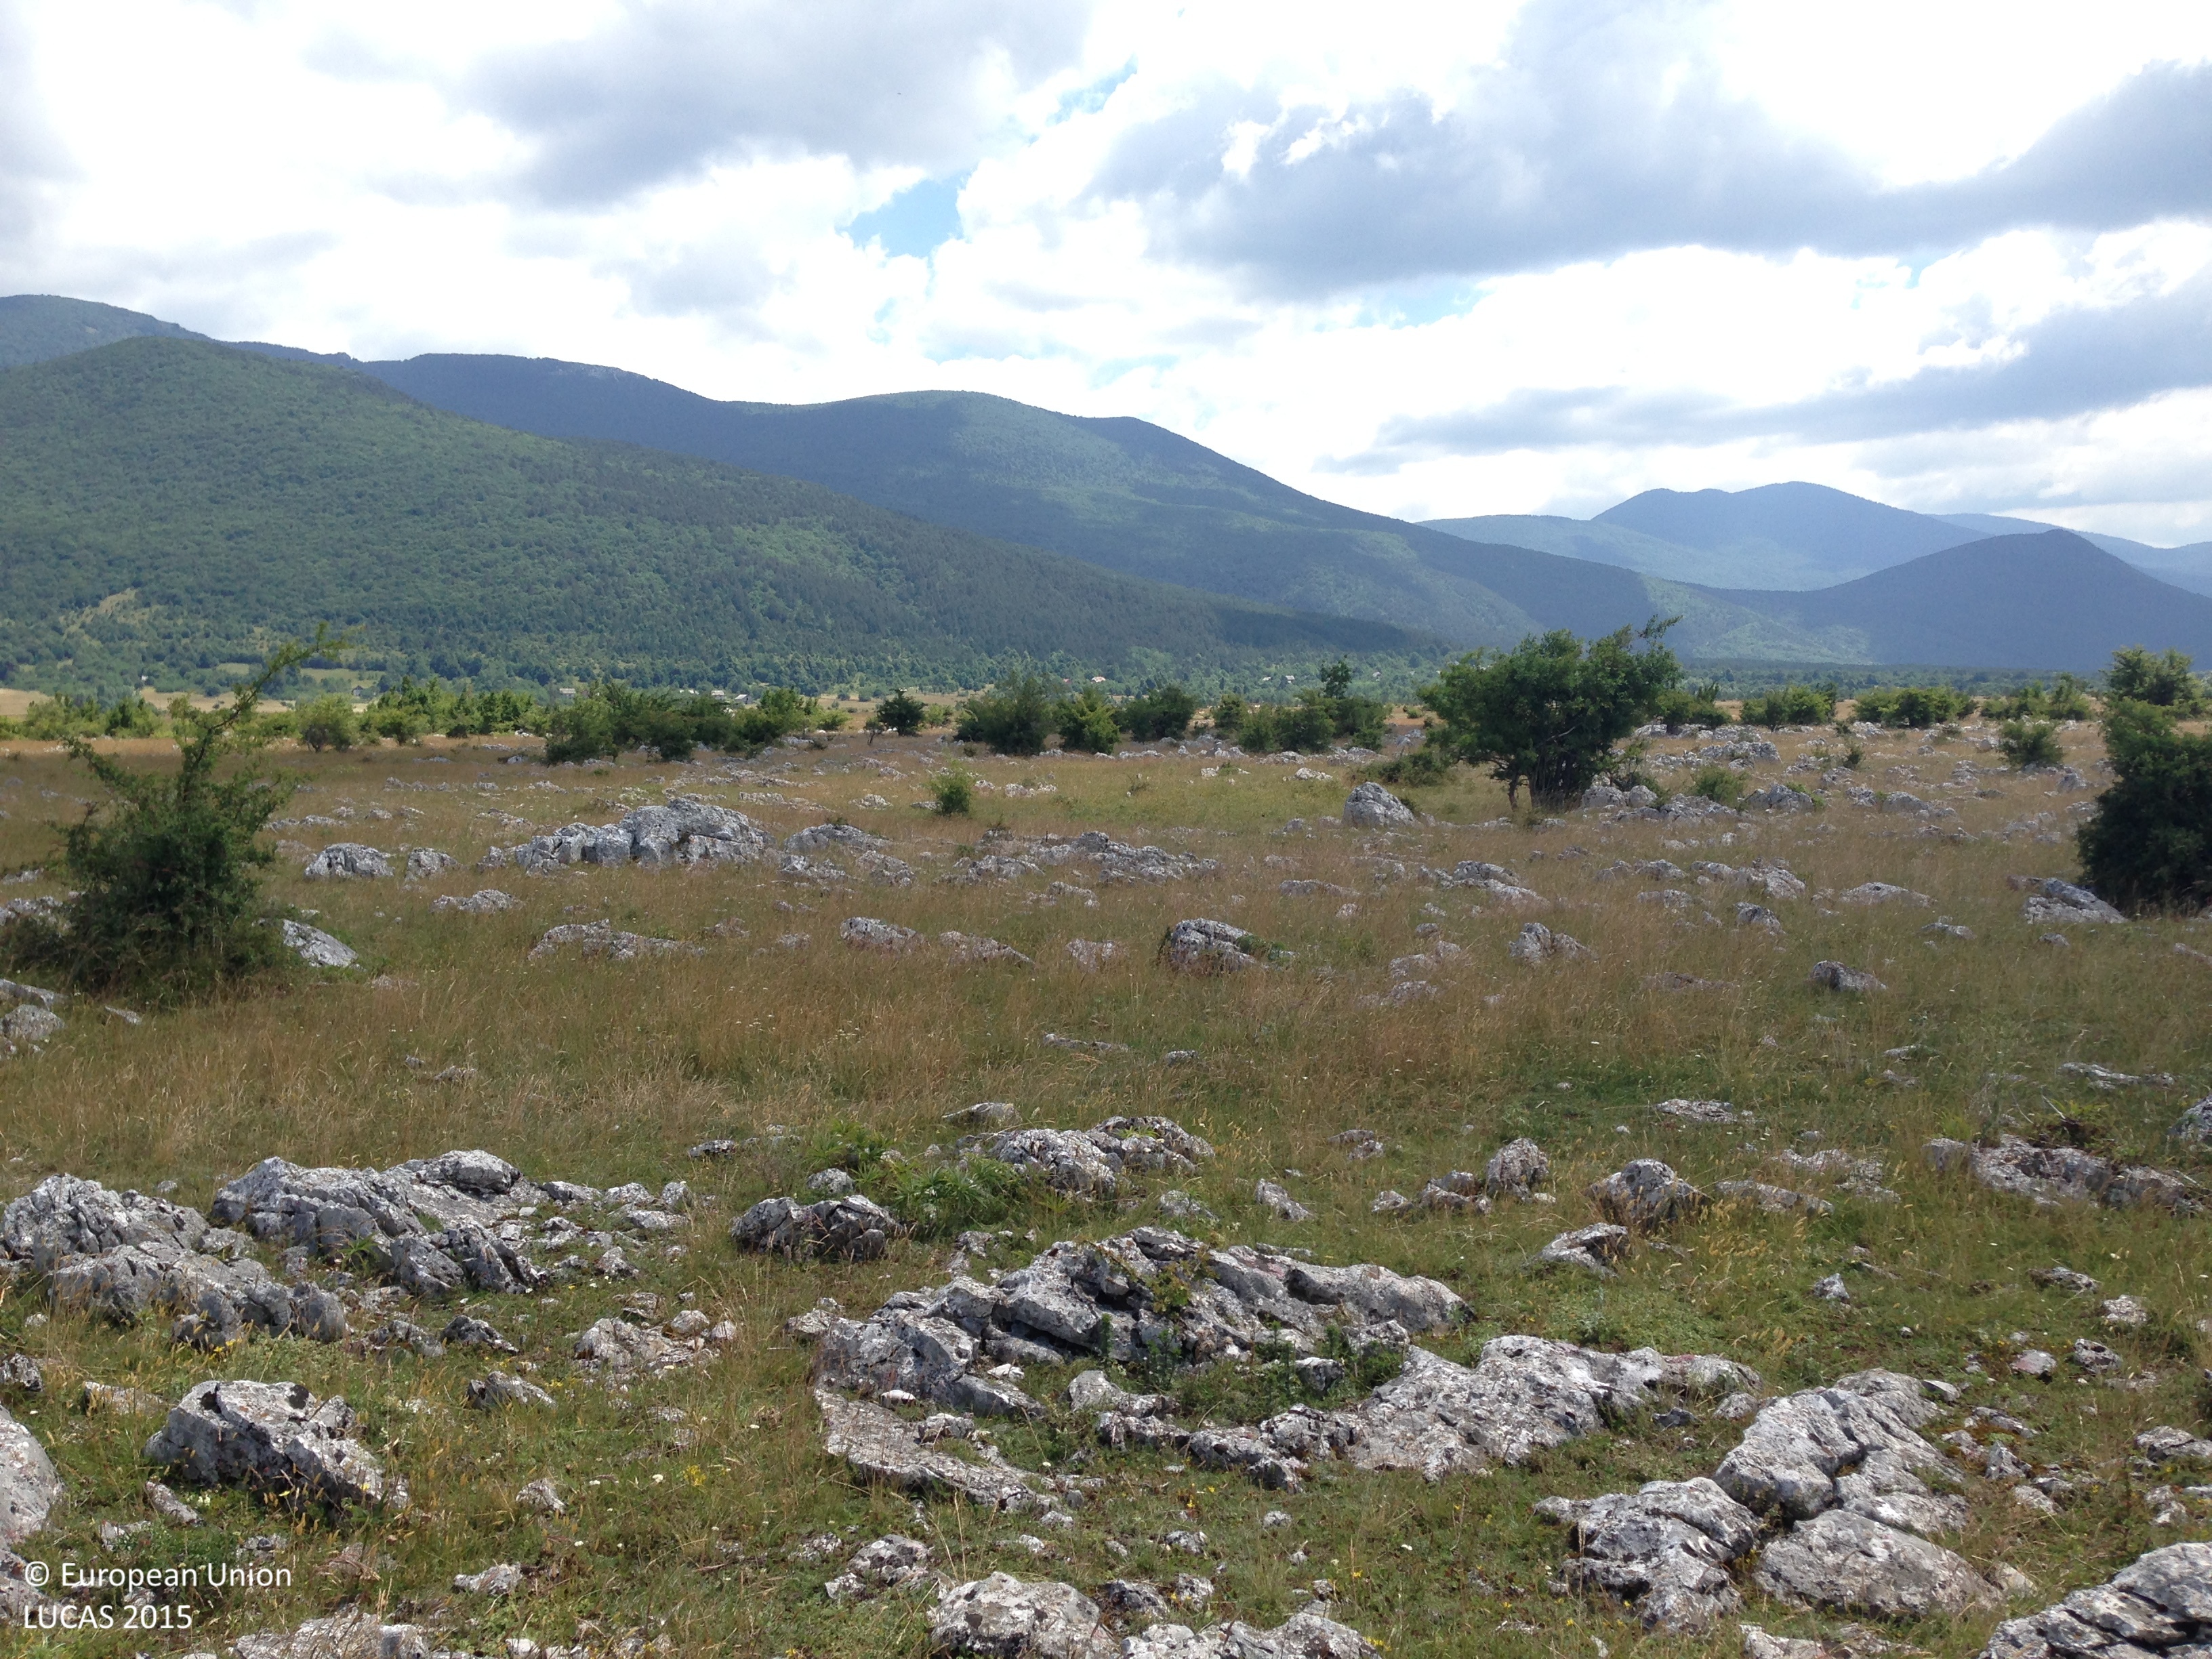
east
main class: Grassland
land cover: Grassland with sparse tree/shrub cover
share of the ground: > 75 %
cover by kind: herbaceous plants 65 %, unconsolidated bare surface 15 %, consolidated bare surface 10 %, broadleaved forest trees 5 %, shrubs 5 %
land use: Semi-natural and natural areas not in use
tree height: < 5 m
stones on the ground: < 10 %
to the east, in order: Grassland with sparse tree/shrub cover; Tracks; Grassland with sparse tree/shrub cover; Tracks; Grassland with sparse tree/shrub cover; Rocks and stones; Grassland without tree/shrub cover
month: June
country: HR
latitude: 44.7533
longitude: 15.7165
